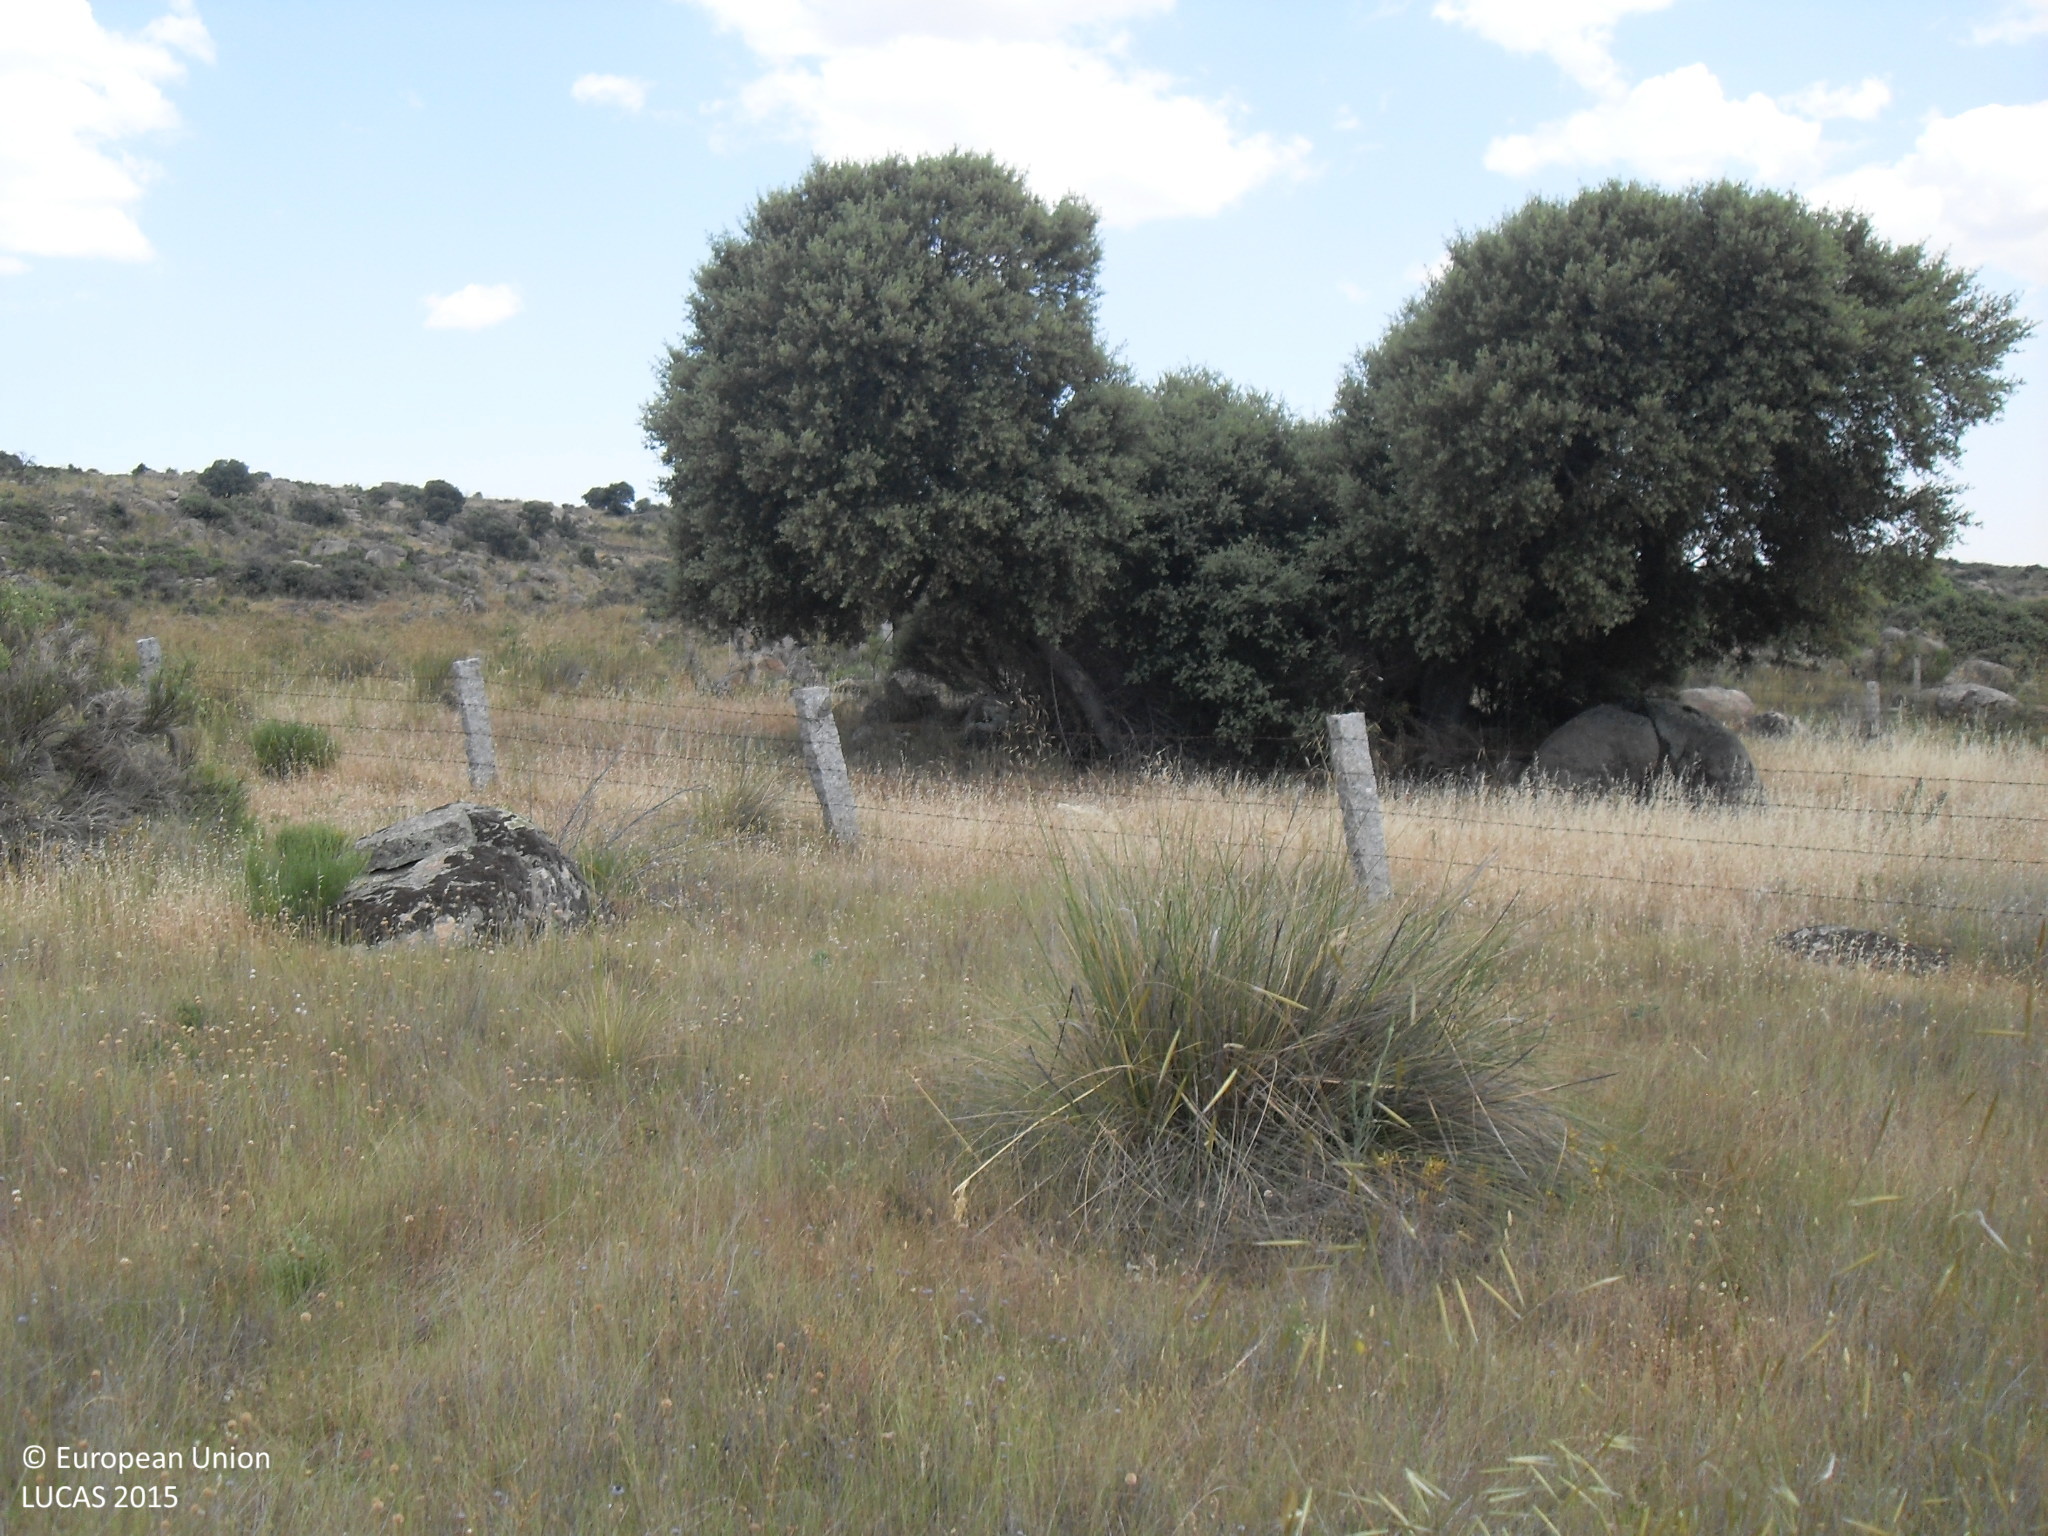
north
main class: Grassland
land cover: Grassland without tree/shrub cover
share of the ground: > 75 %
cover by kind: herbaceous plants 100 %
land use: Agriculture (excluding fallow land and kitchen gardens)
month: June
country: ES
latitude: 40.4565
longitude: -5.5267
